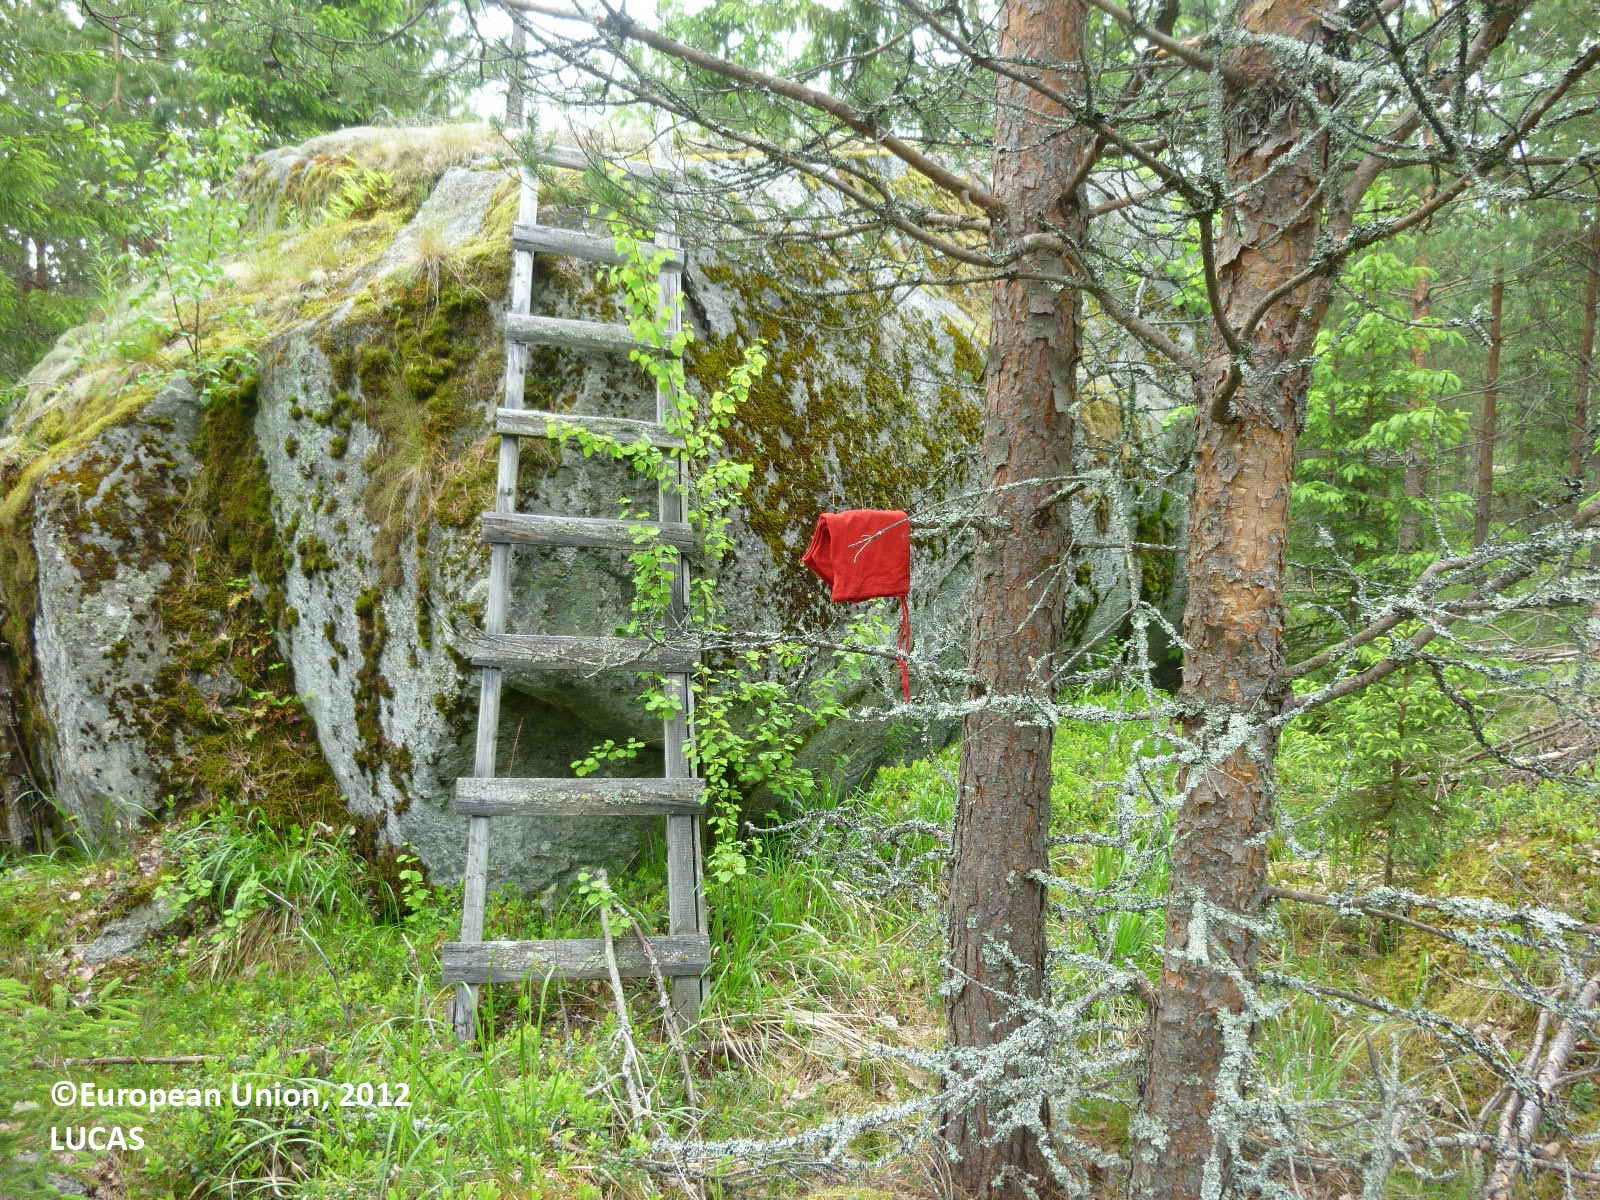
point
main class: Woodland
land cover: Other coniferous woodland
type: boreal forest
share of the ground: 50 - 75 %
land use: Forestry
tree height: > 5 m
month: June
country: FI
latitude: 61.5426
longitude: 22.0404
